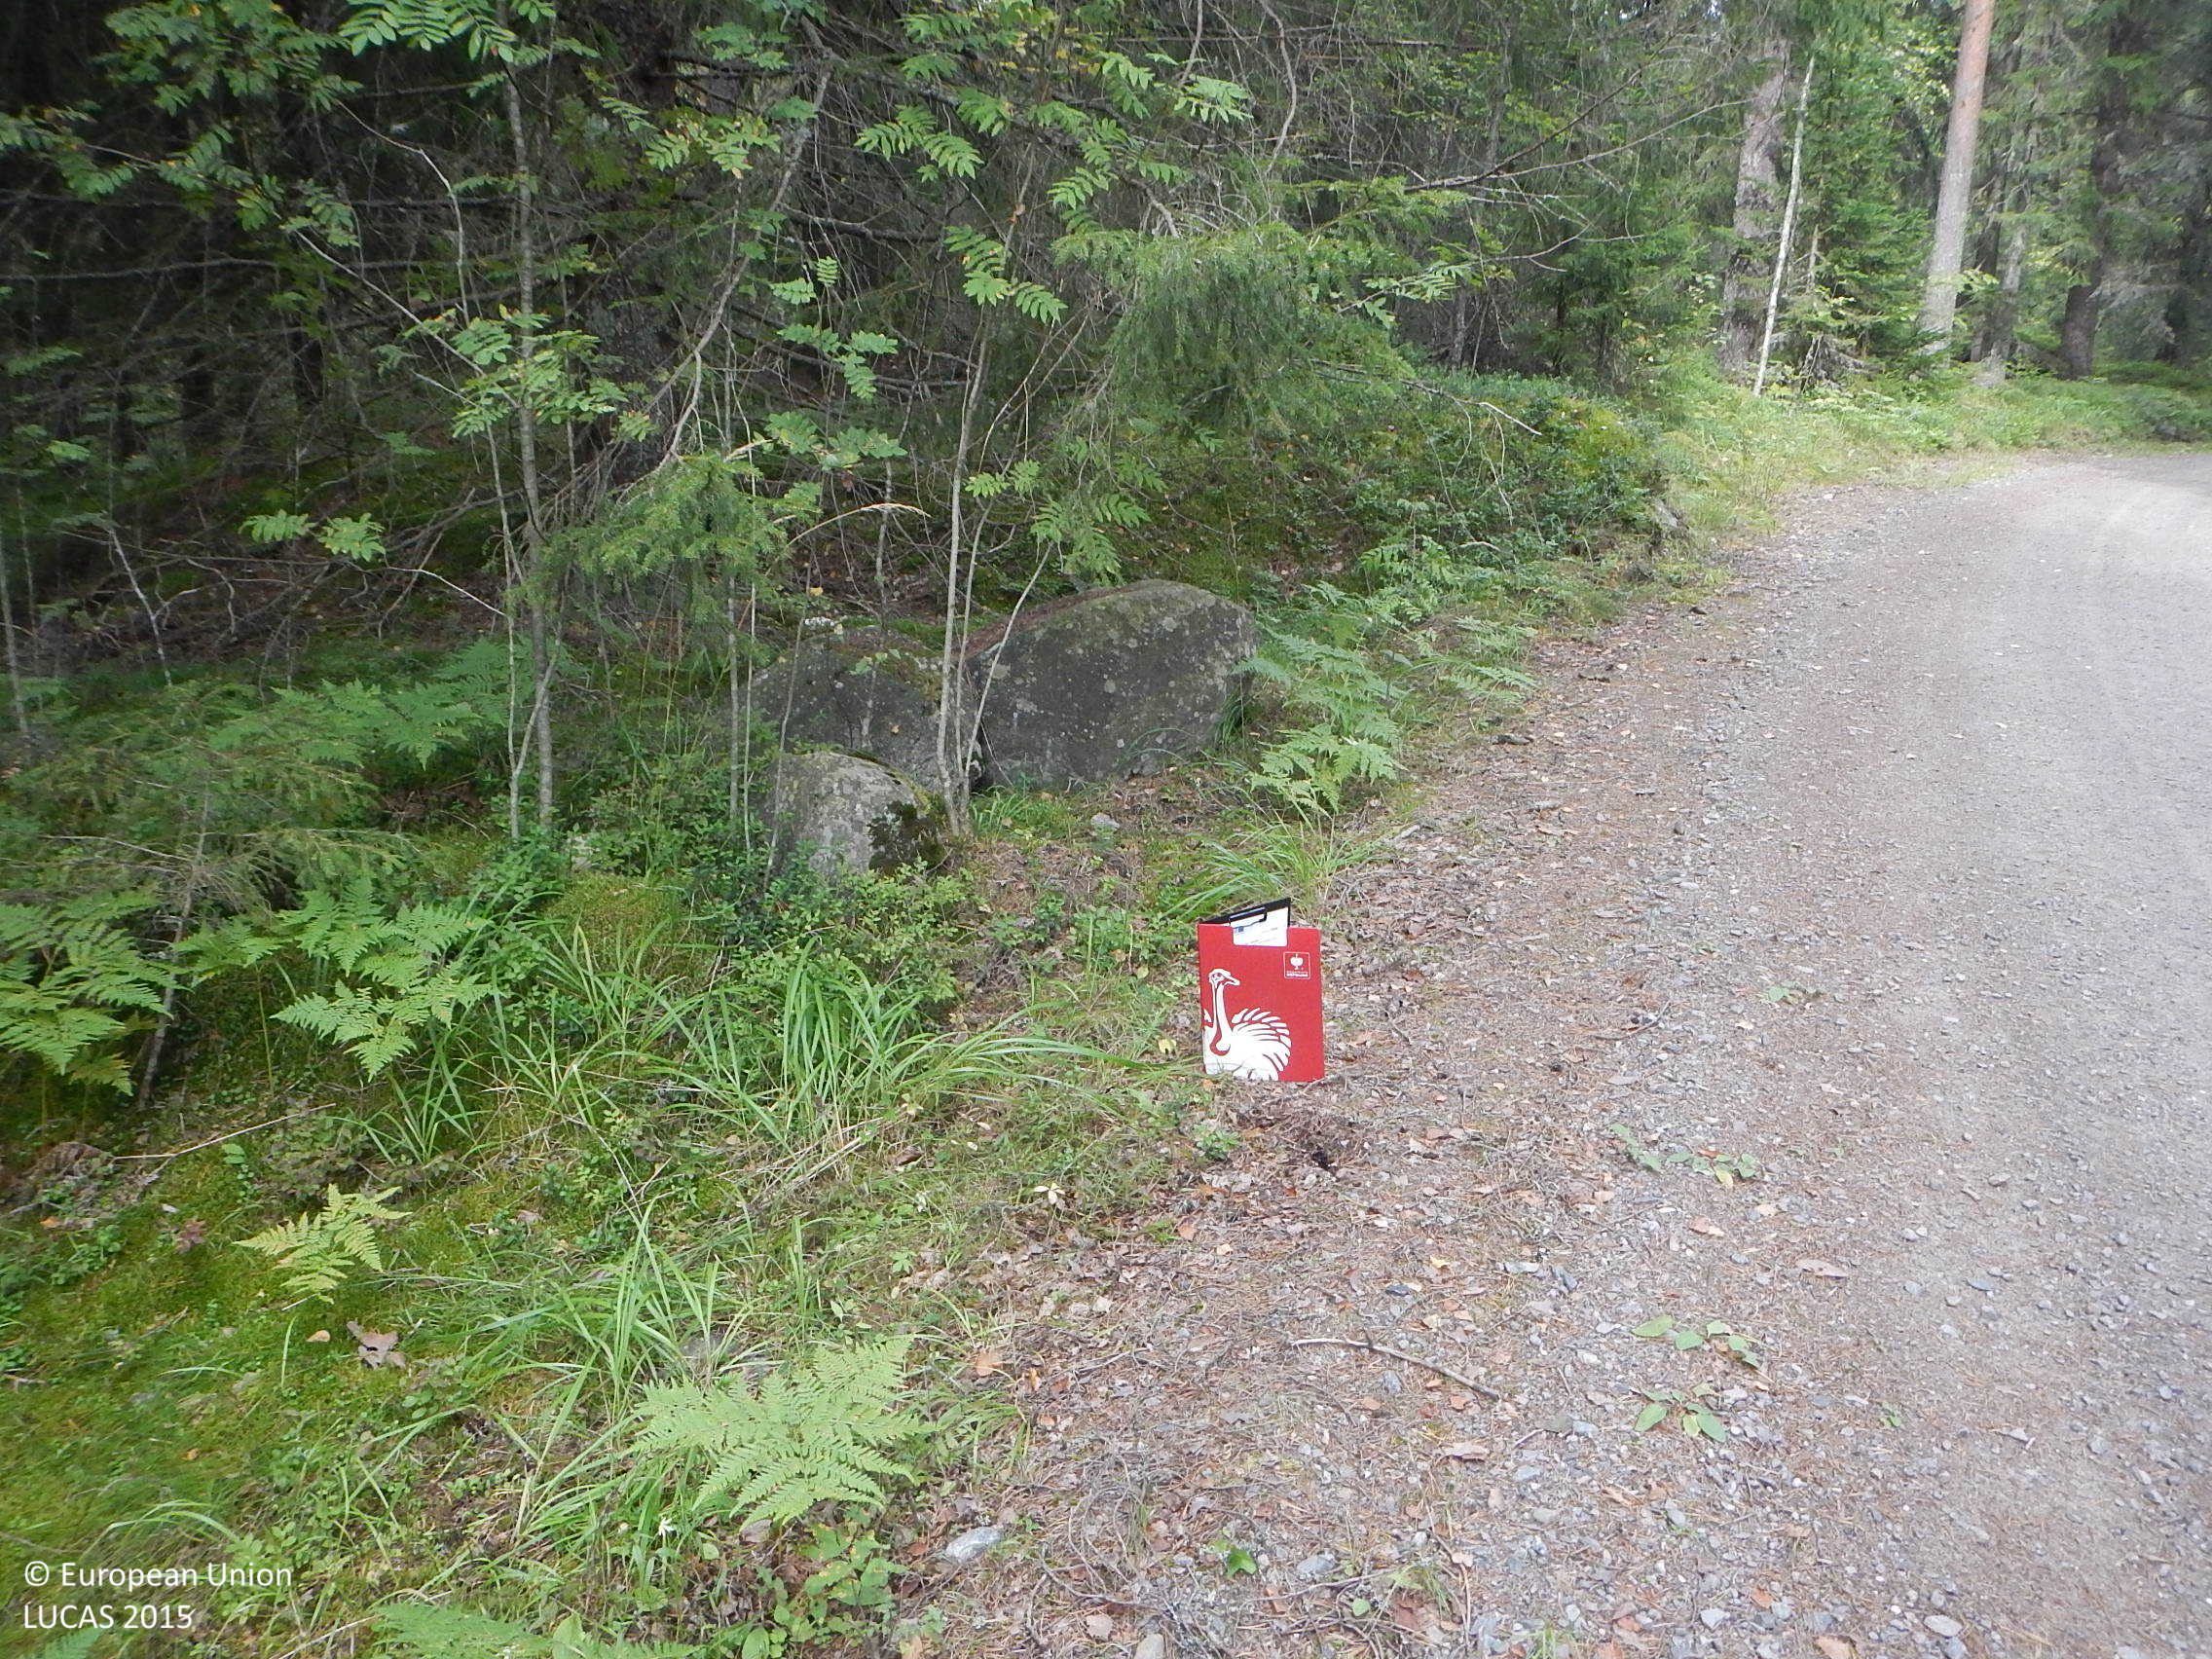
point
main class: Woodland
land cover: Other coniferous woodland
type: boreal forest
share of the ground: > 75 %
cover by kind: coniferous forest trees 75 %, shrubs 10 %, herbaceous plants 10 %, lichens and mosses 5 %
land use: Forestry
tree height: > 5 m
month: September
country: FI
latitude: 61.4809
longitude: 22.9692
